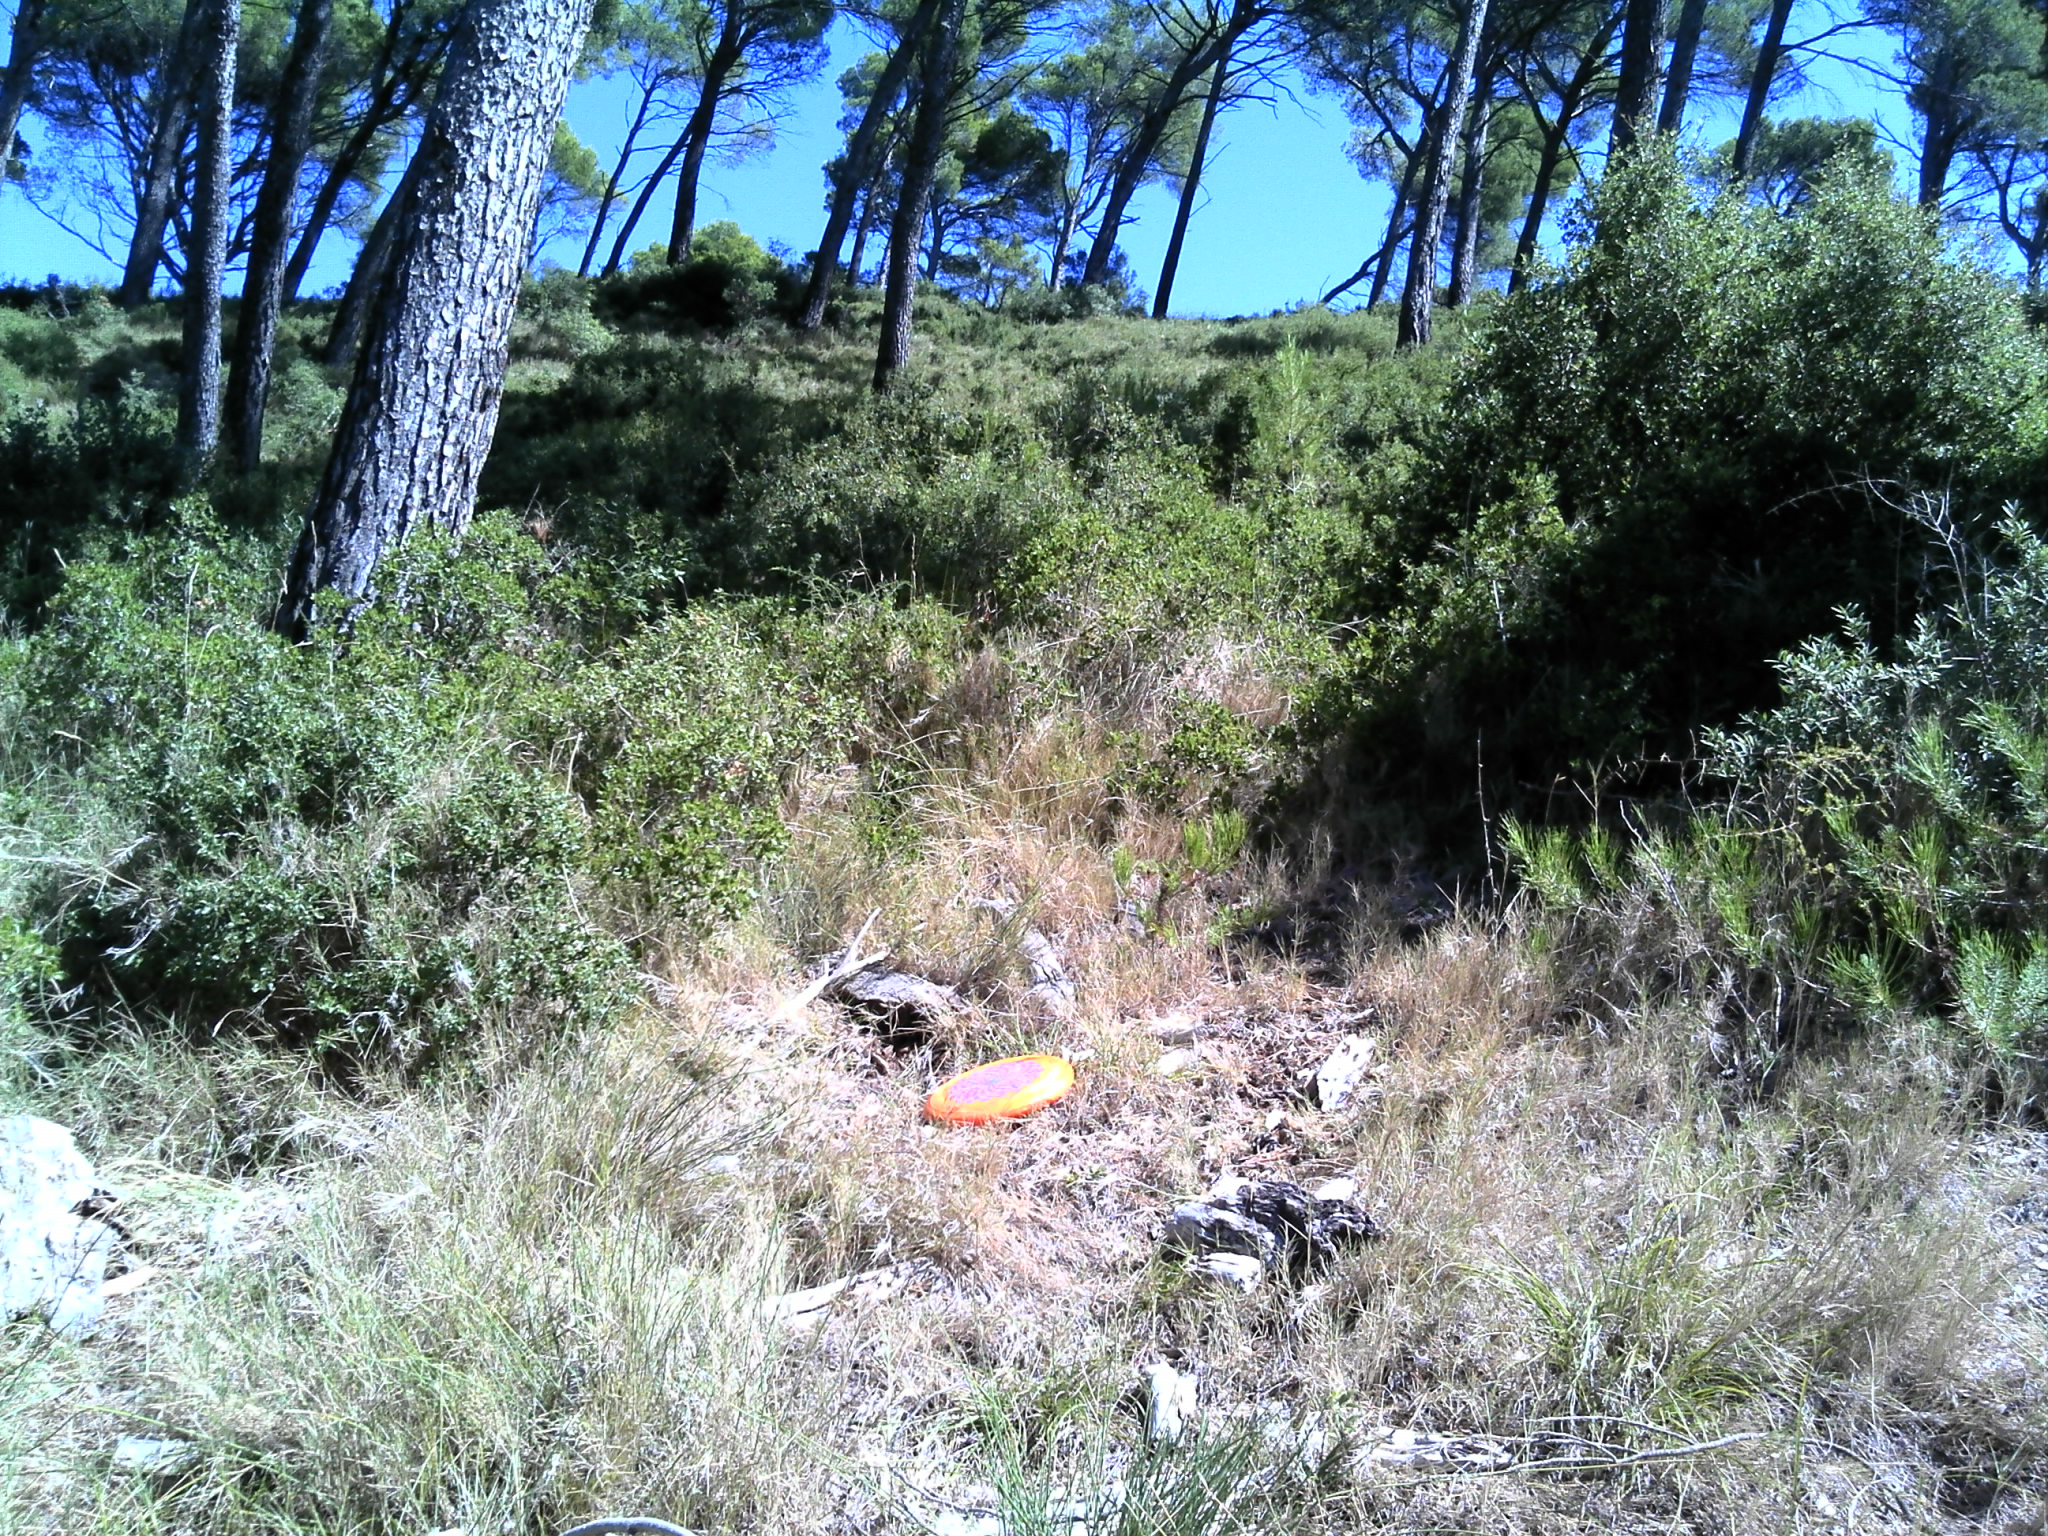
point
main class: Woodland
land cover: Pine dominated coniferous woodland
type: coniferous forest of the mediterranean region
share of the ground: 50 - 75 %
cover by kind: coniferous forest trees 50 %, shrubs 30 %, herbaceous plants 20 %
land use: Forestry
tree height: > 5 m
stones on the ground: < 10 %
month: September
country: FR
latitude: 43.7663
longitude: 5.1272
